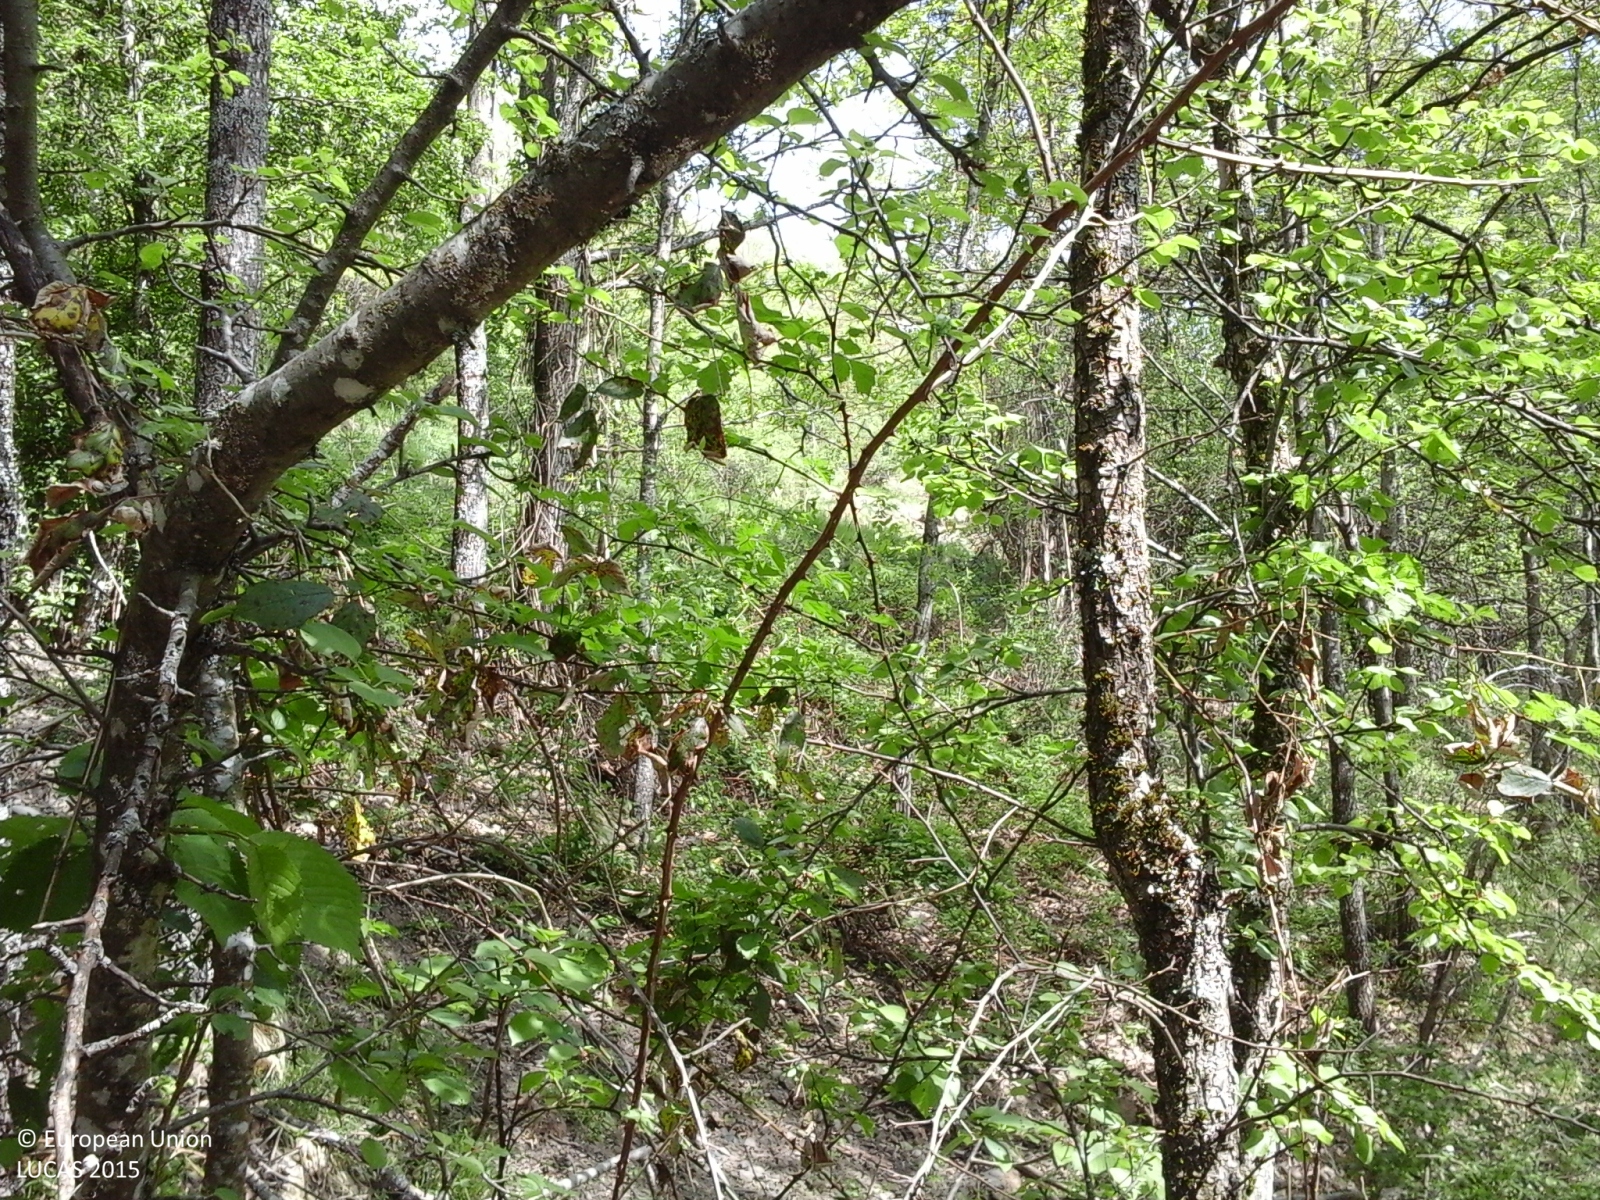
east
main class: Woodland
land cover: Other mixed woodland
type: thermophilous deciduous forest
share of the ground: > 75 %
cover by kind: broadleaved forest trees 50 %, coniferous forest trees 25 %, shrubs 25 %
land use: Forestry
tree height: > 5 m
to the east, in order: Other mixed woodland; Grass margins; Paved roads, cycling and walking lanes; Broadleaved woodland; Grass margins; Paved roads, cycling and walking lanes; Shrubland with sparse tree cover; Broadleaved woodland
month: May
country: IT
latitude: 44.6191
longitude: 9.3587
